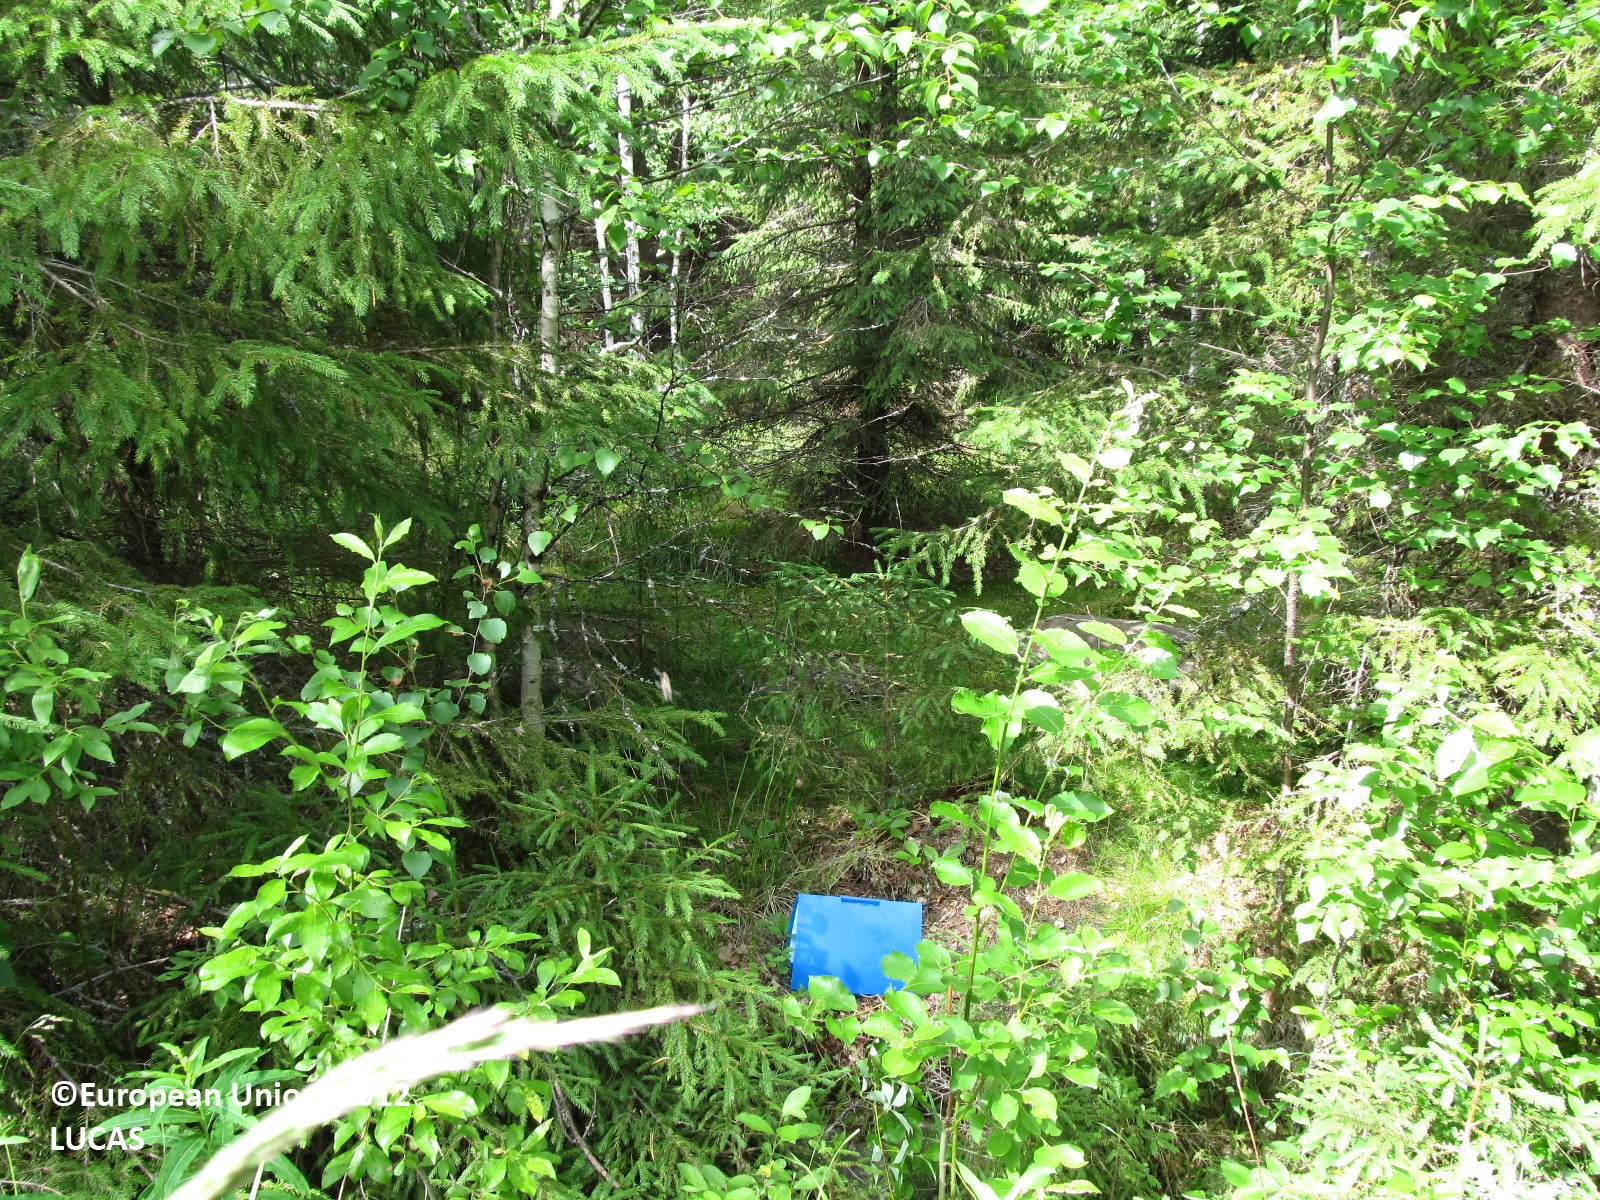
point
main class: Woodland
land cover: Spruce dominated mixed woodland
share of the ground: 25 - 50 %
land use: Forestry
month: July
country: FI
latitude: 62.0455
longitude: 28.7845
